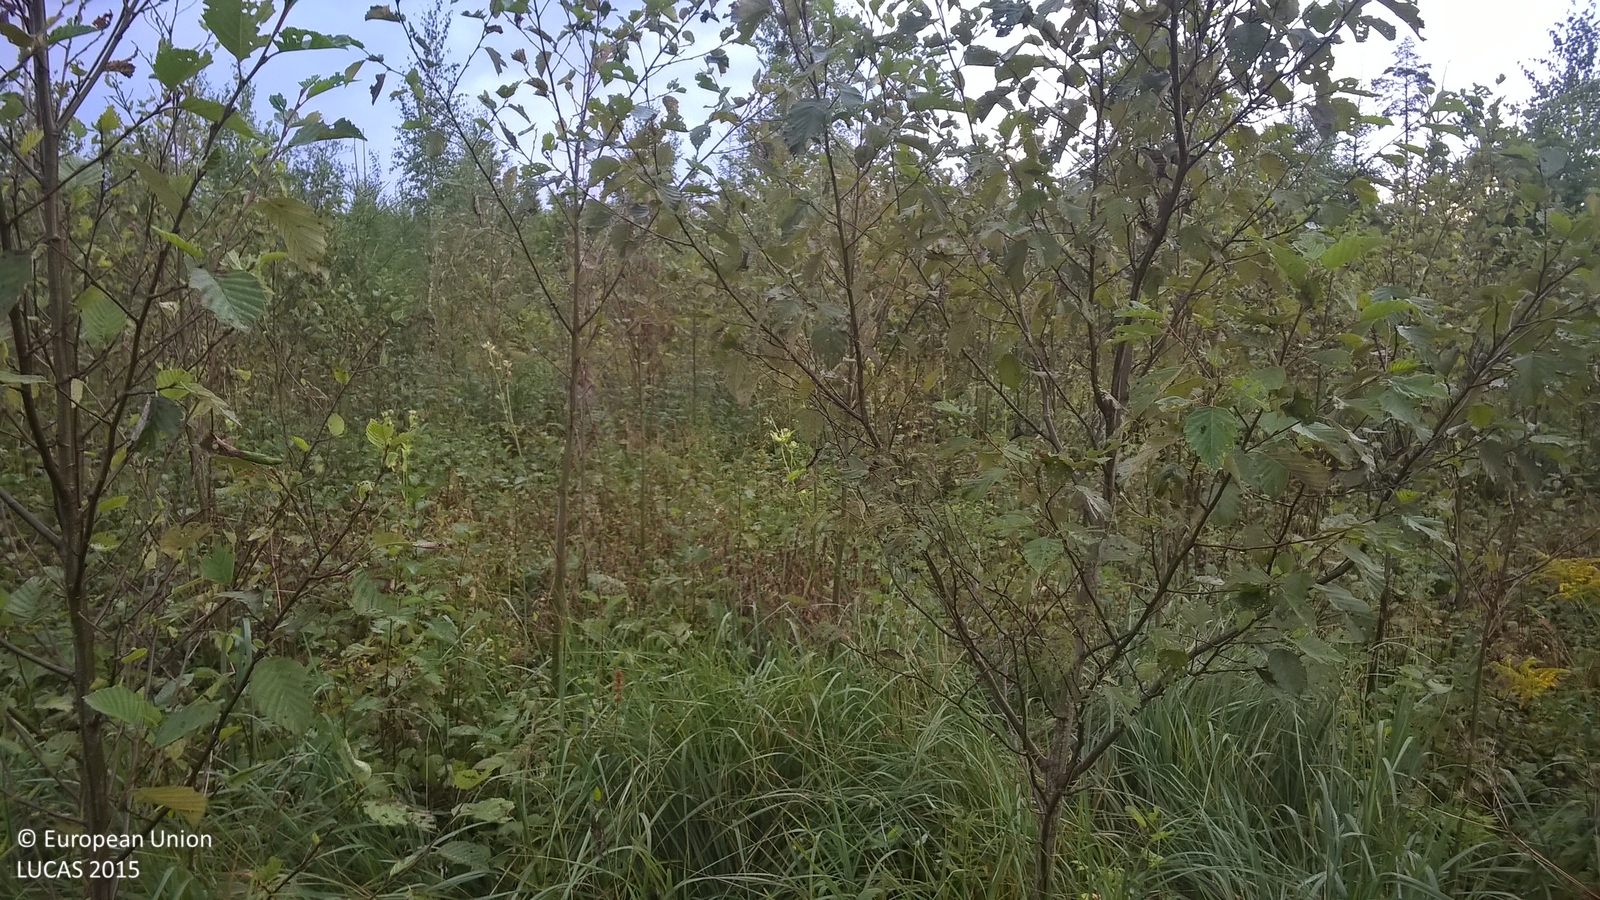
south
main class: Woodland
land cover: Broadleaved woodland
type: non-riverine alder, birch or aspen forest
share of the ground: 50 - 75 %
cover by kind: broadleaved forest trees 70 %, herbaceous plants 30 %
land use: Forestry
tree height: < 5 m
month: September
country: LV
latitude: 57.3676
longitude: 25.4957
